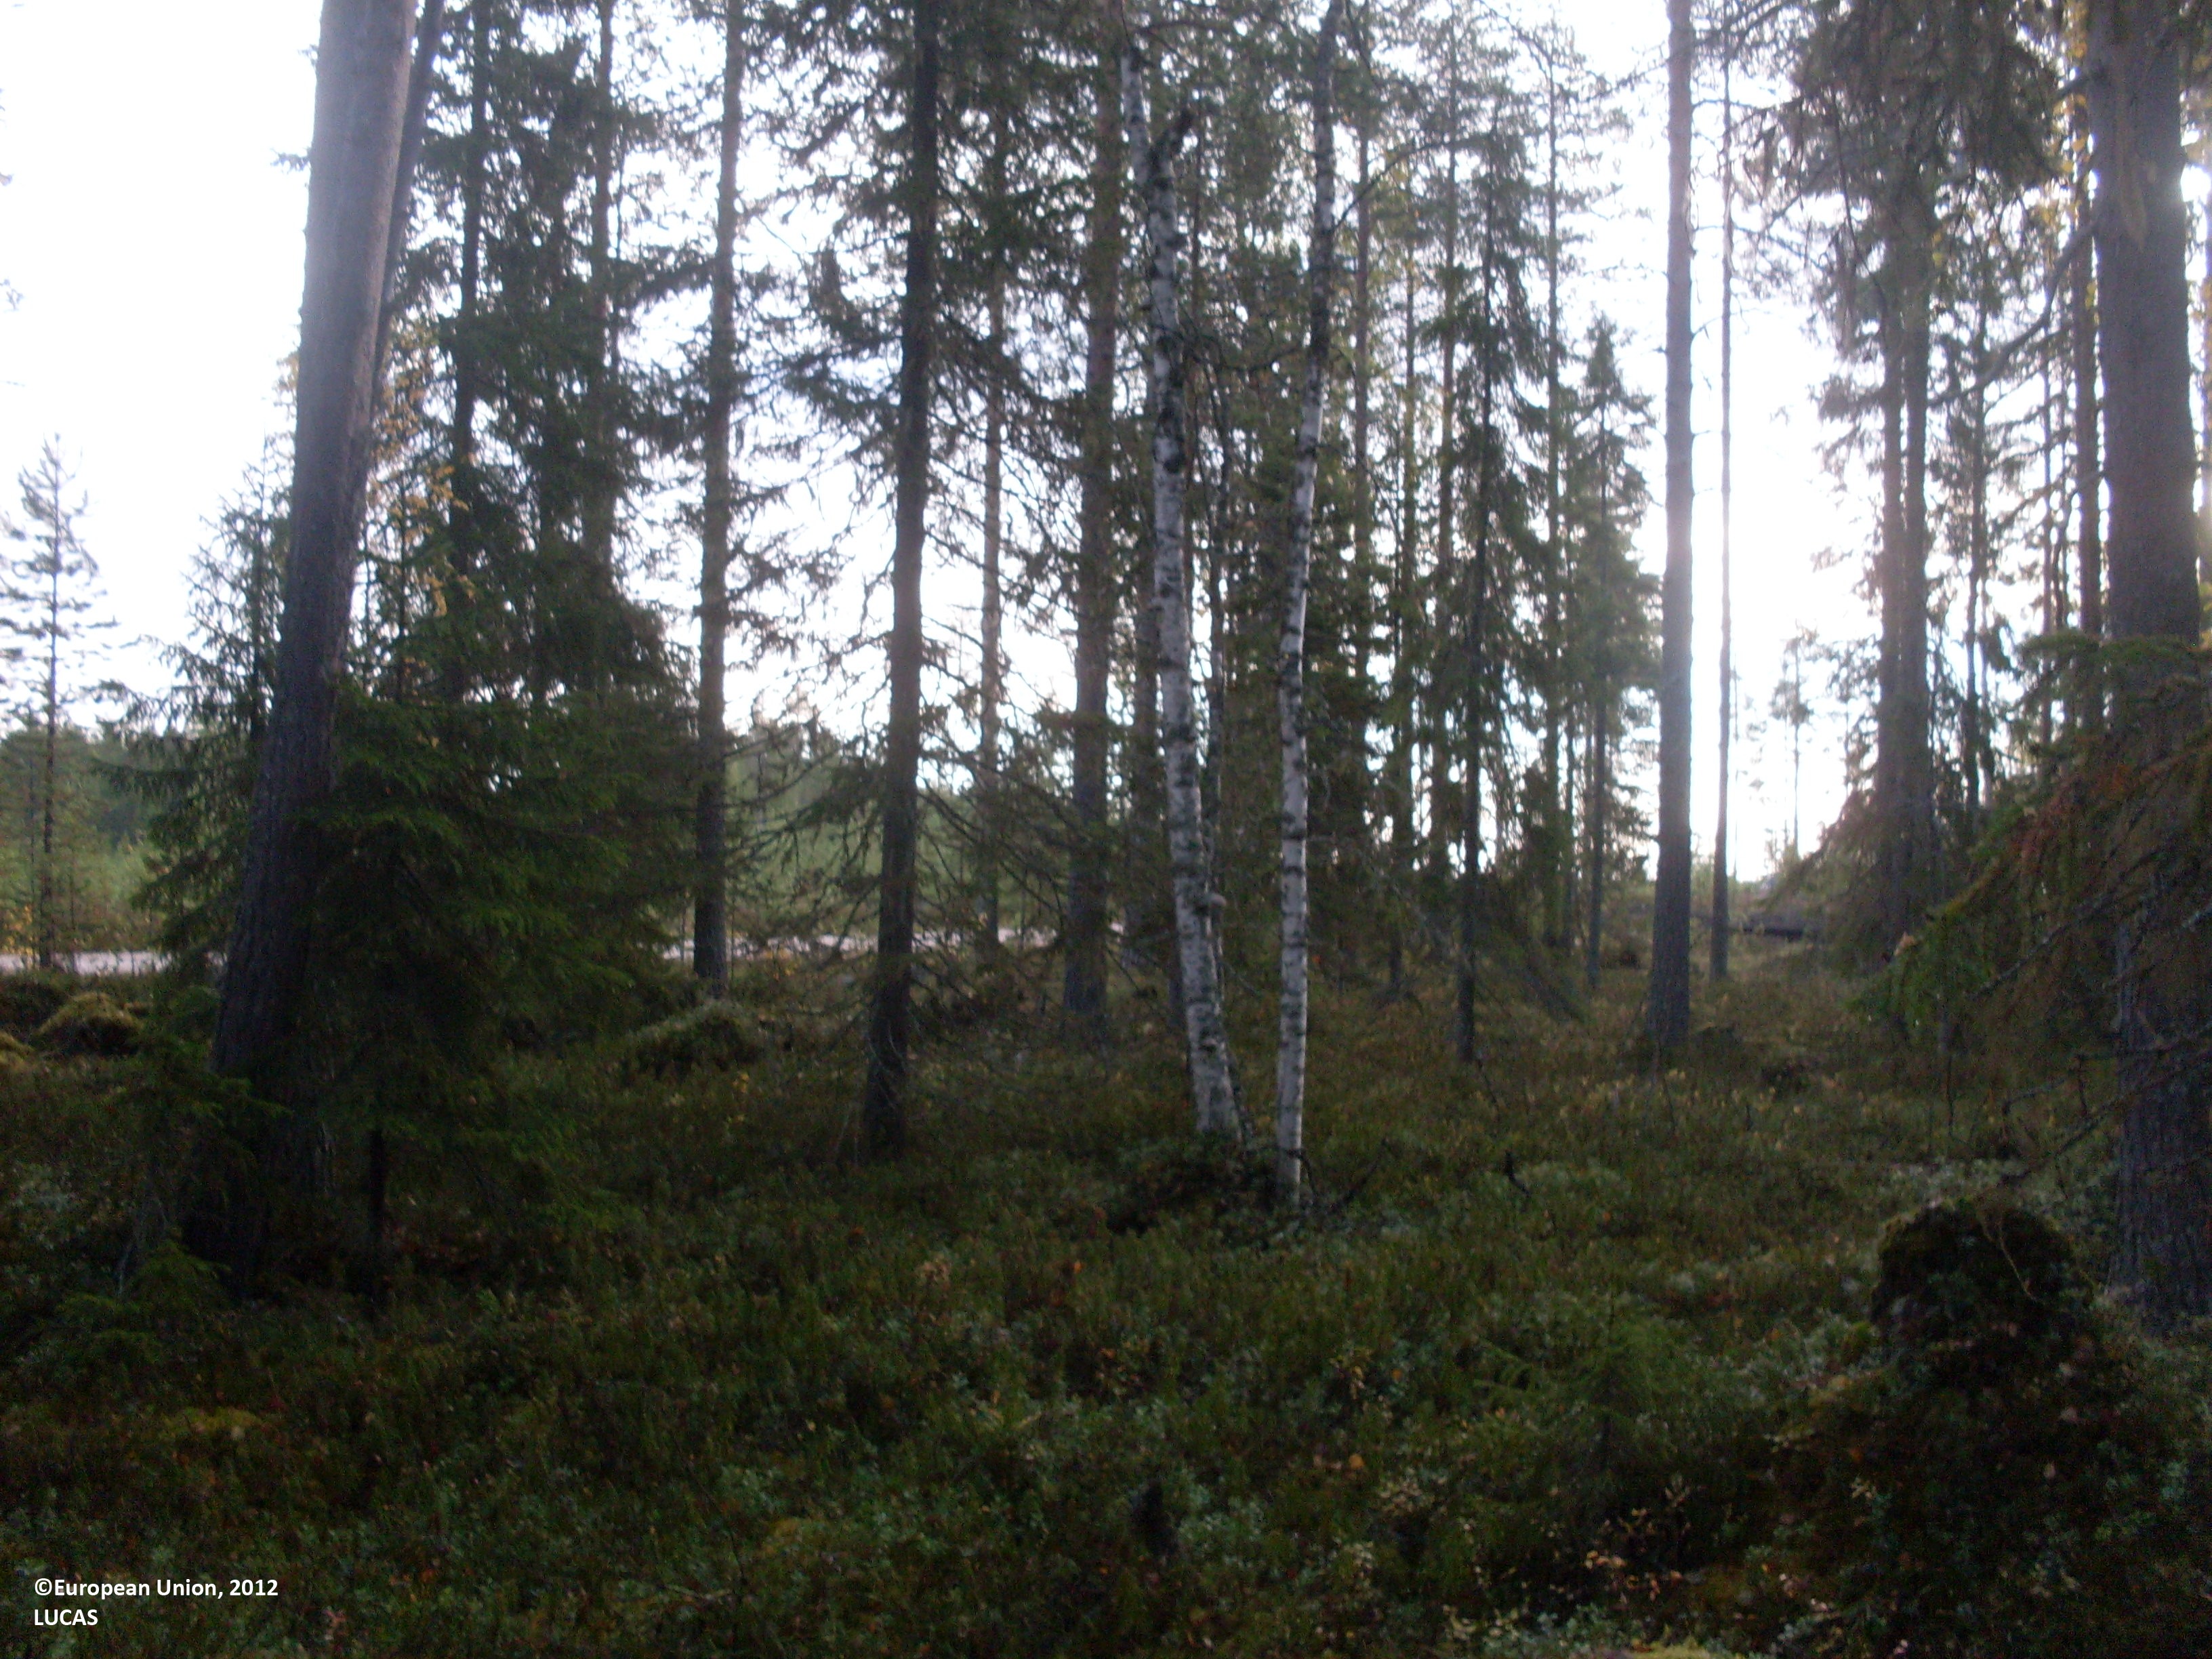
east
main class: Woodland
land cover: Pine dominated mixed woodland
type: boreal forest
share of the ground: 50 - 75 %
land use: Forestry
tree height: > 5 m
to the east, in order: Pine dominated mixed woodland; Paved roads, cycling and walking lanes; Pine dominated coniferous woodland; Paved roads, cycling and walking lanes; Shrubland with sparse tree cover; Pine dominated mixed woodland
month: September
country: FI
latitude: 64.7094
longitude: 29.3151
